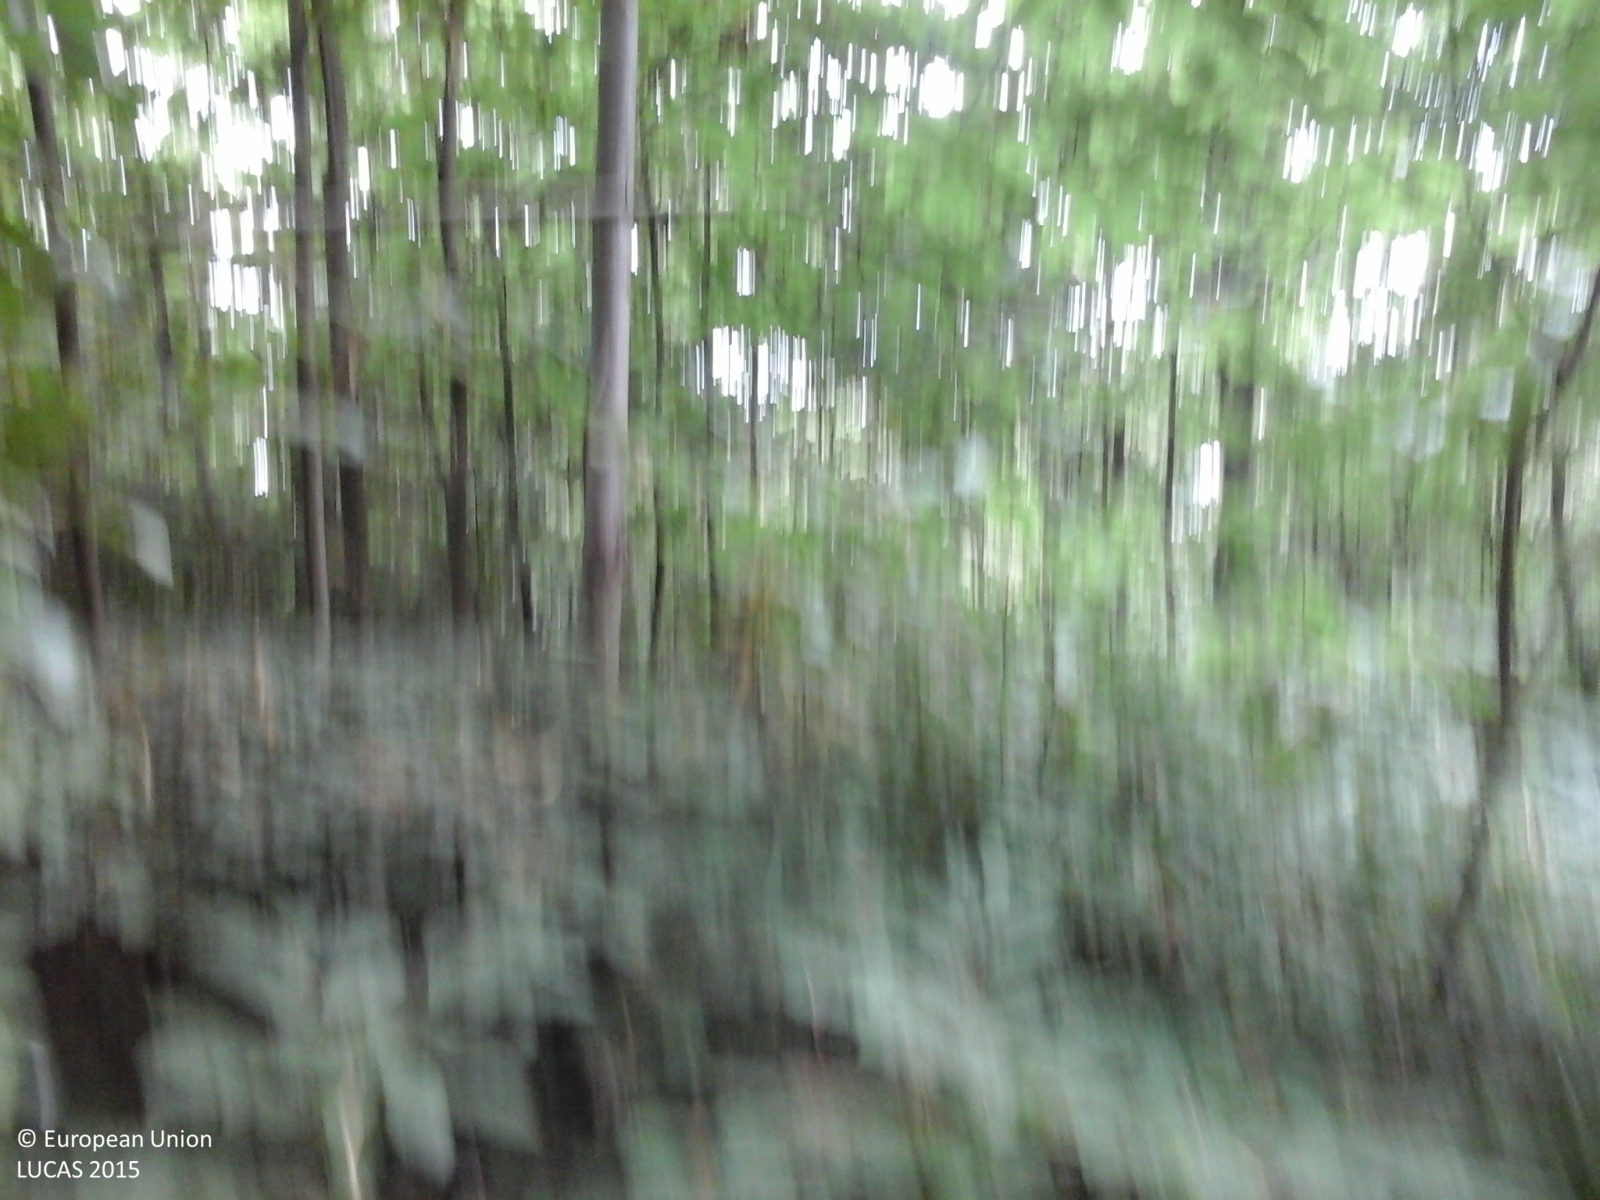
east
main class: Woodland
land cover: Broadleaved woodland
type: thermophilous deciduous forest
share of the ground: > 75 %
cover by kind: broadleaved forest trees 100 %
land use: Semi-natural and natural areas not in use
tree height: > 5 m
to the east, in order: Broadleaved woodland
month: July
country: IT
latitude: 45.0664
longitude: 7.7813
